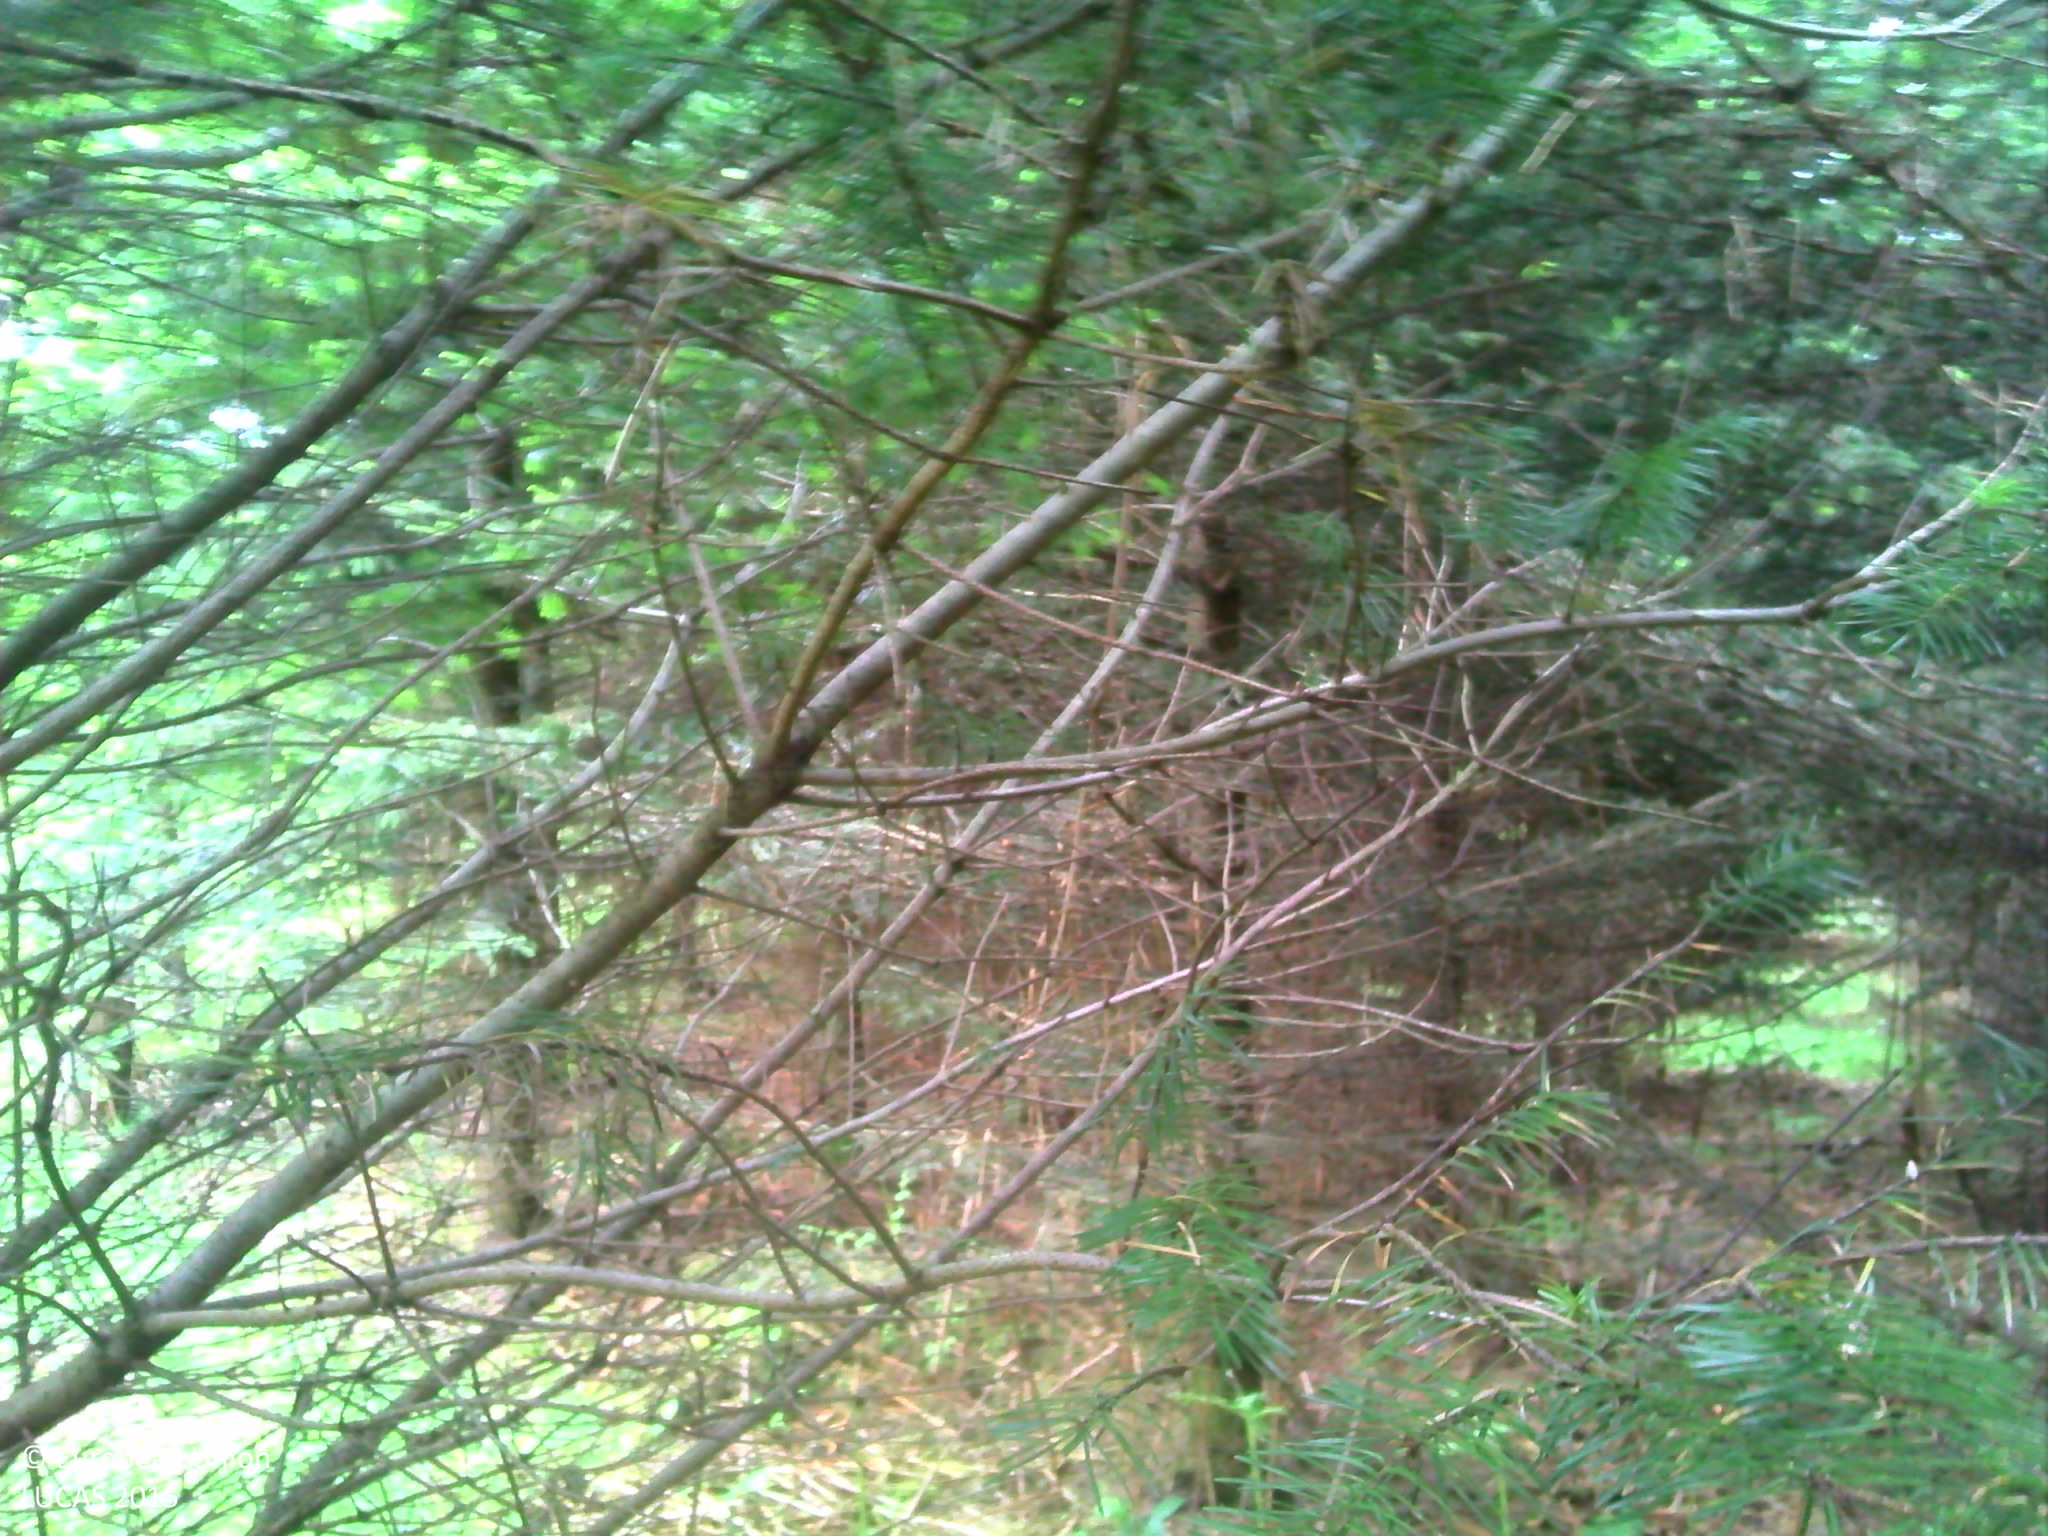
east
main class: Woodland
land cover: Spruce dominated coniferous woodland
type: exotic forest
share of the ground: > 75 %
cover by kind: coniferous forest trees 85 %, herbaceous plants 15 %
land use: Forestry
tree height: > 5 m
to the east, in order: Spruce dominated coniferous woodland; Grass margins; Paved roads, cycling and walking lanes; Grass margins; Ditches and canals; Other coniferous woodland; Tracks; Spruce dominated coniferous woodland; Ditches and canals; Grass margins; Tracks; Grassland without tree/shrub cover; Spruce dominated coniferous woodland
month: June
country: BE
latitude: 49.9420
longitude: 4.8552
